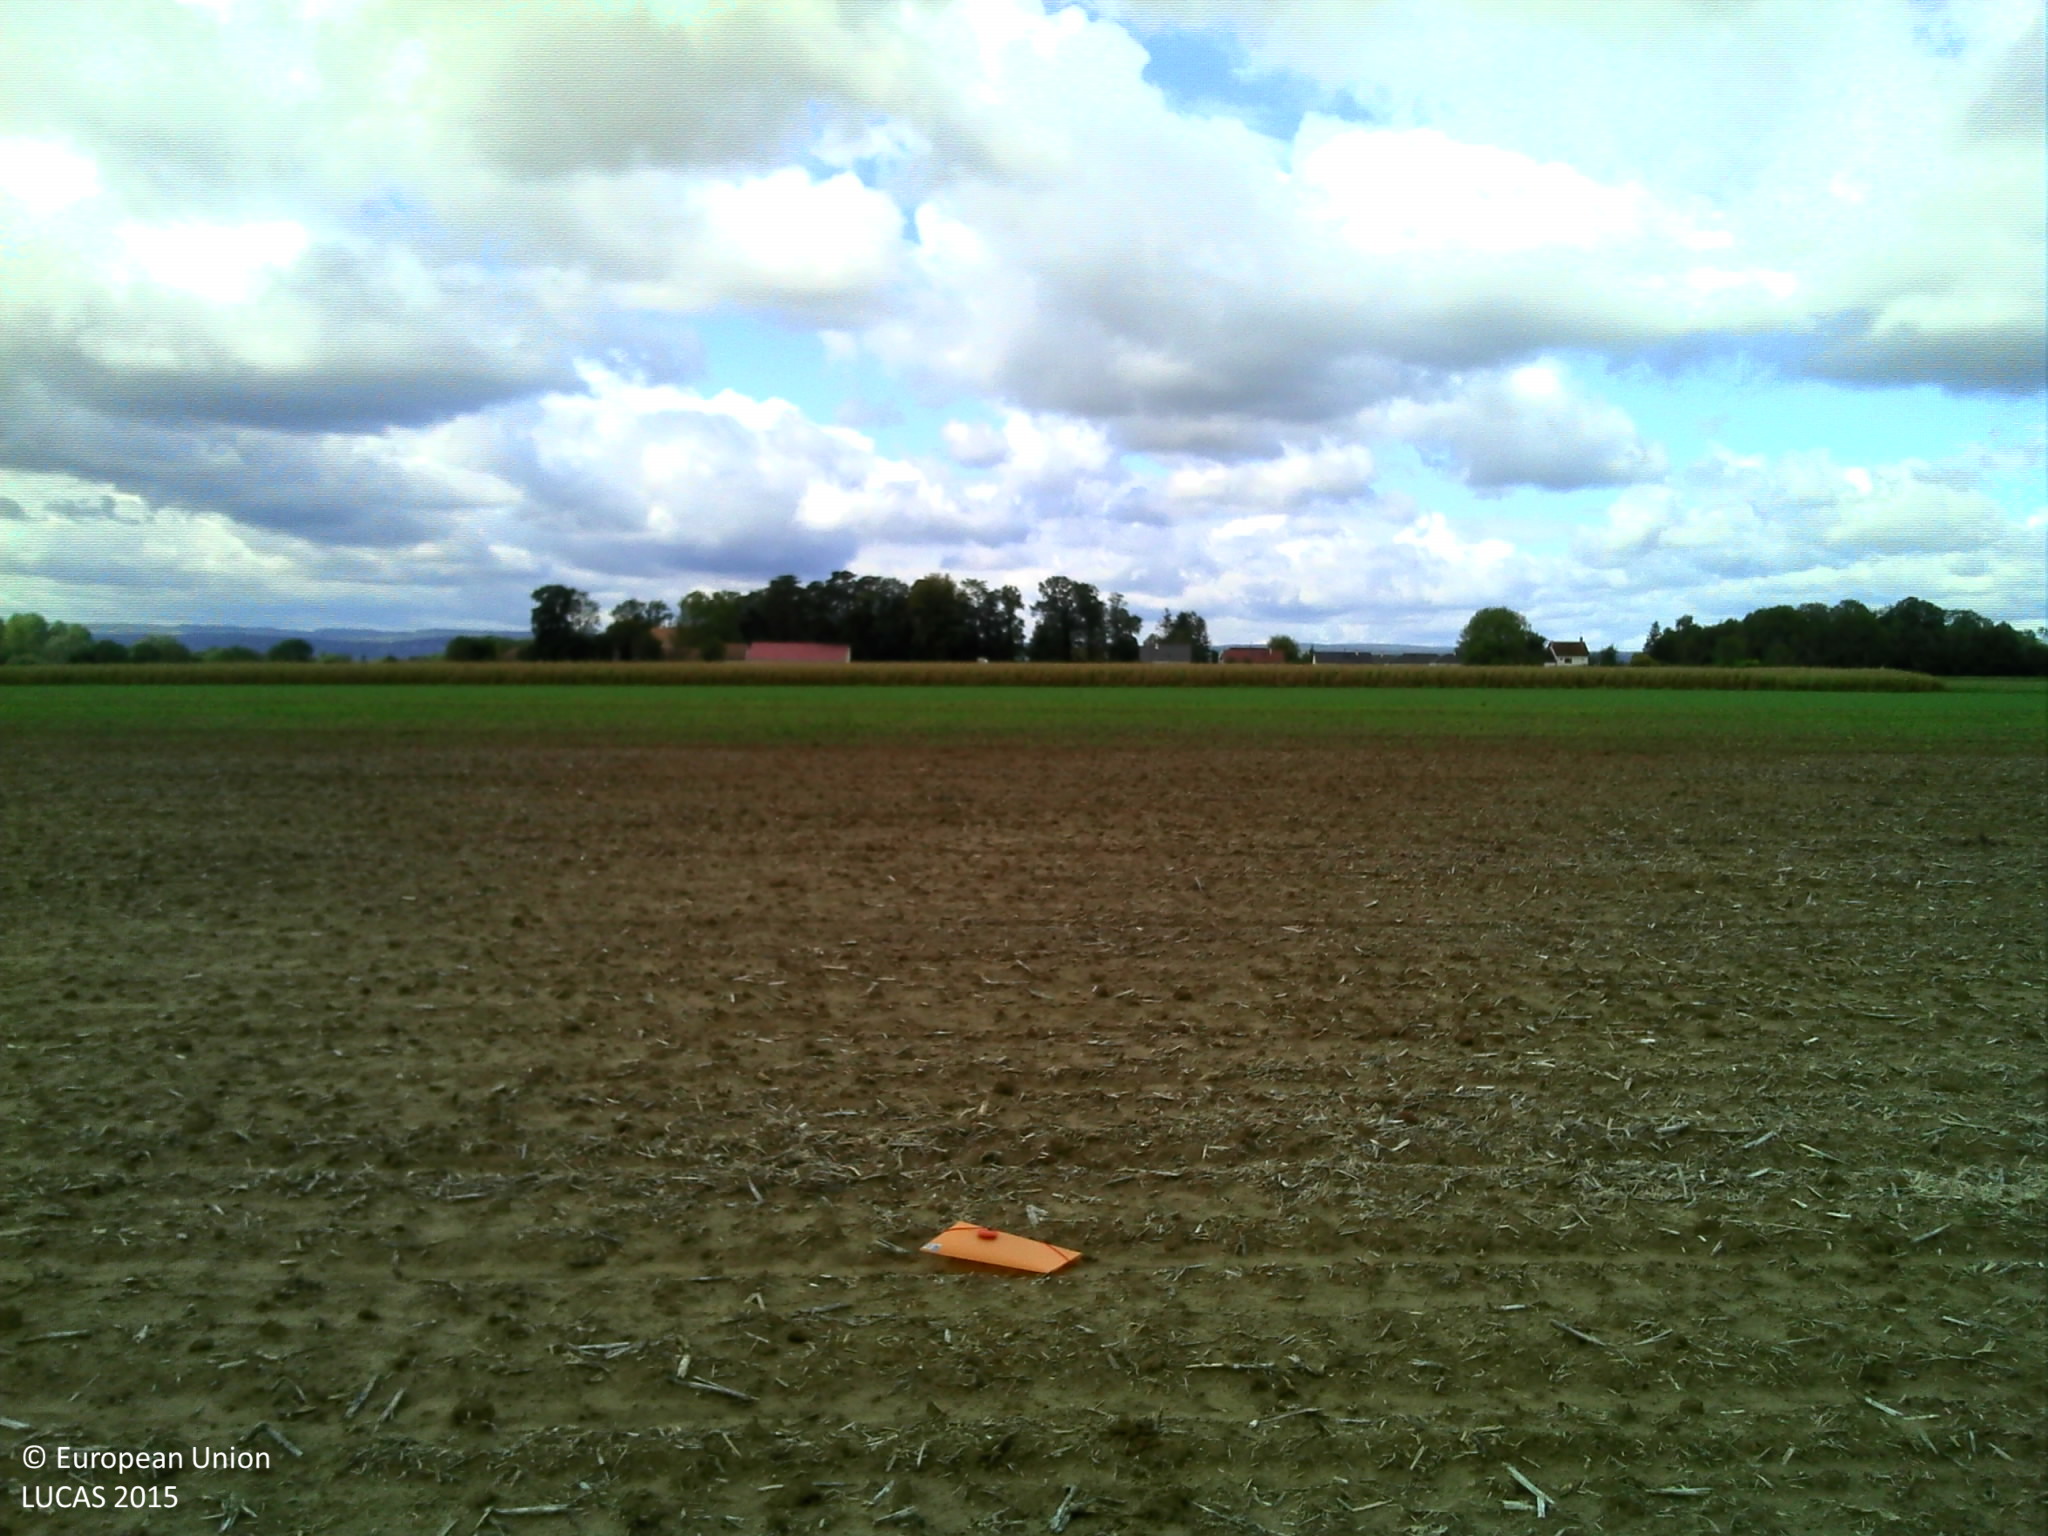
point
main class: Cropland
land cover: Rape and turnip rape
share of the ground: < 10 %
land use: Agriculture (excluding fallow land and kitchen gardens)
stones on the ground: < 10 %
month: September
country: FR
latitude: 47.0072
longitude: 4.9371
